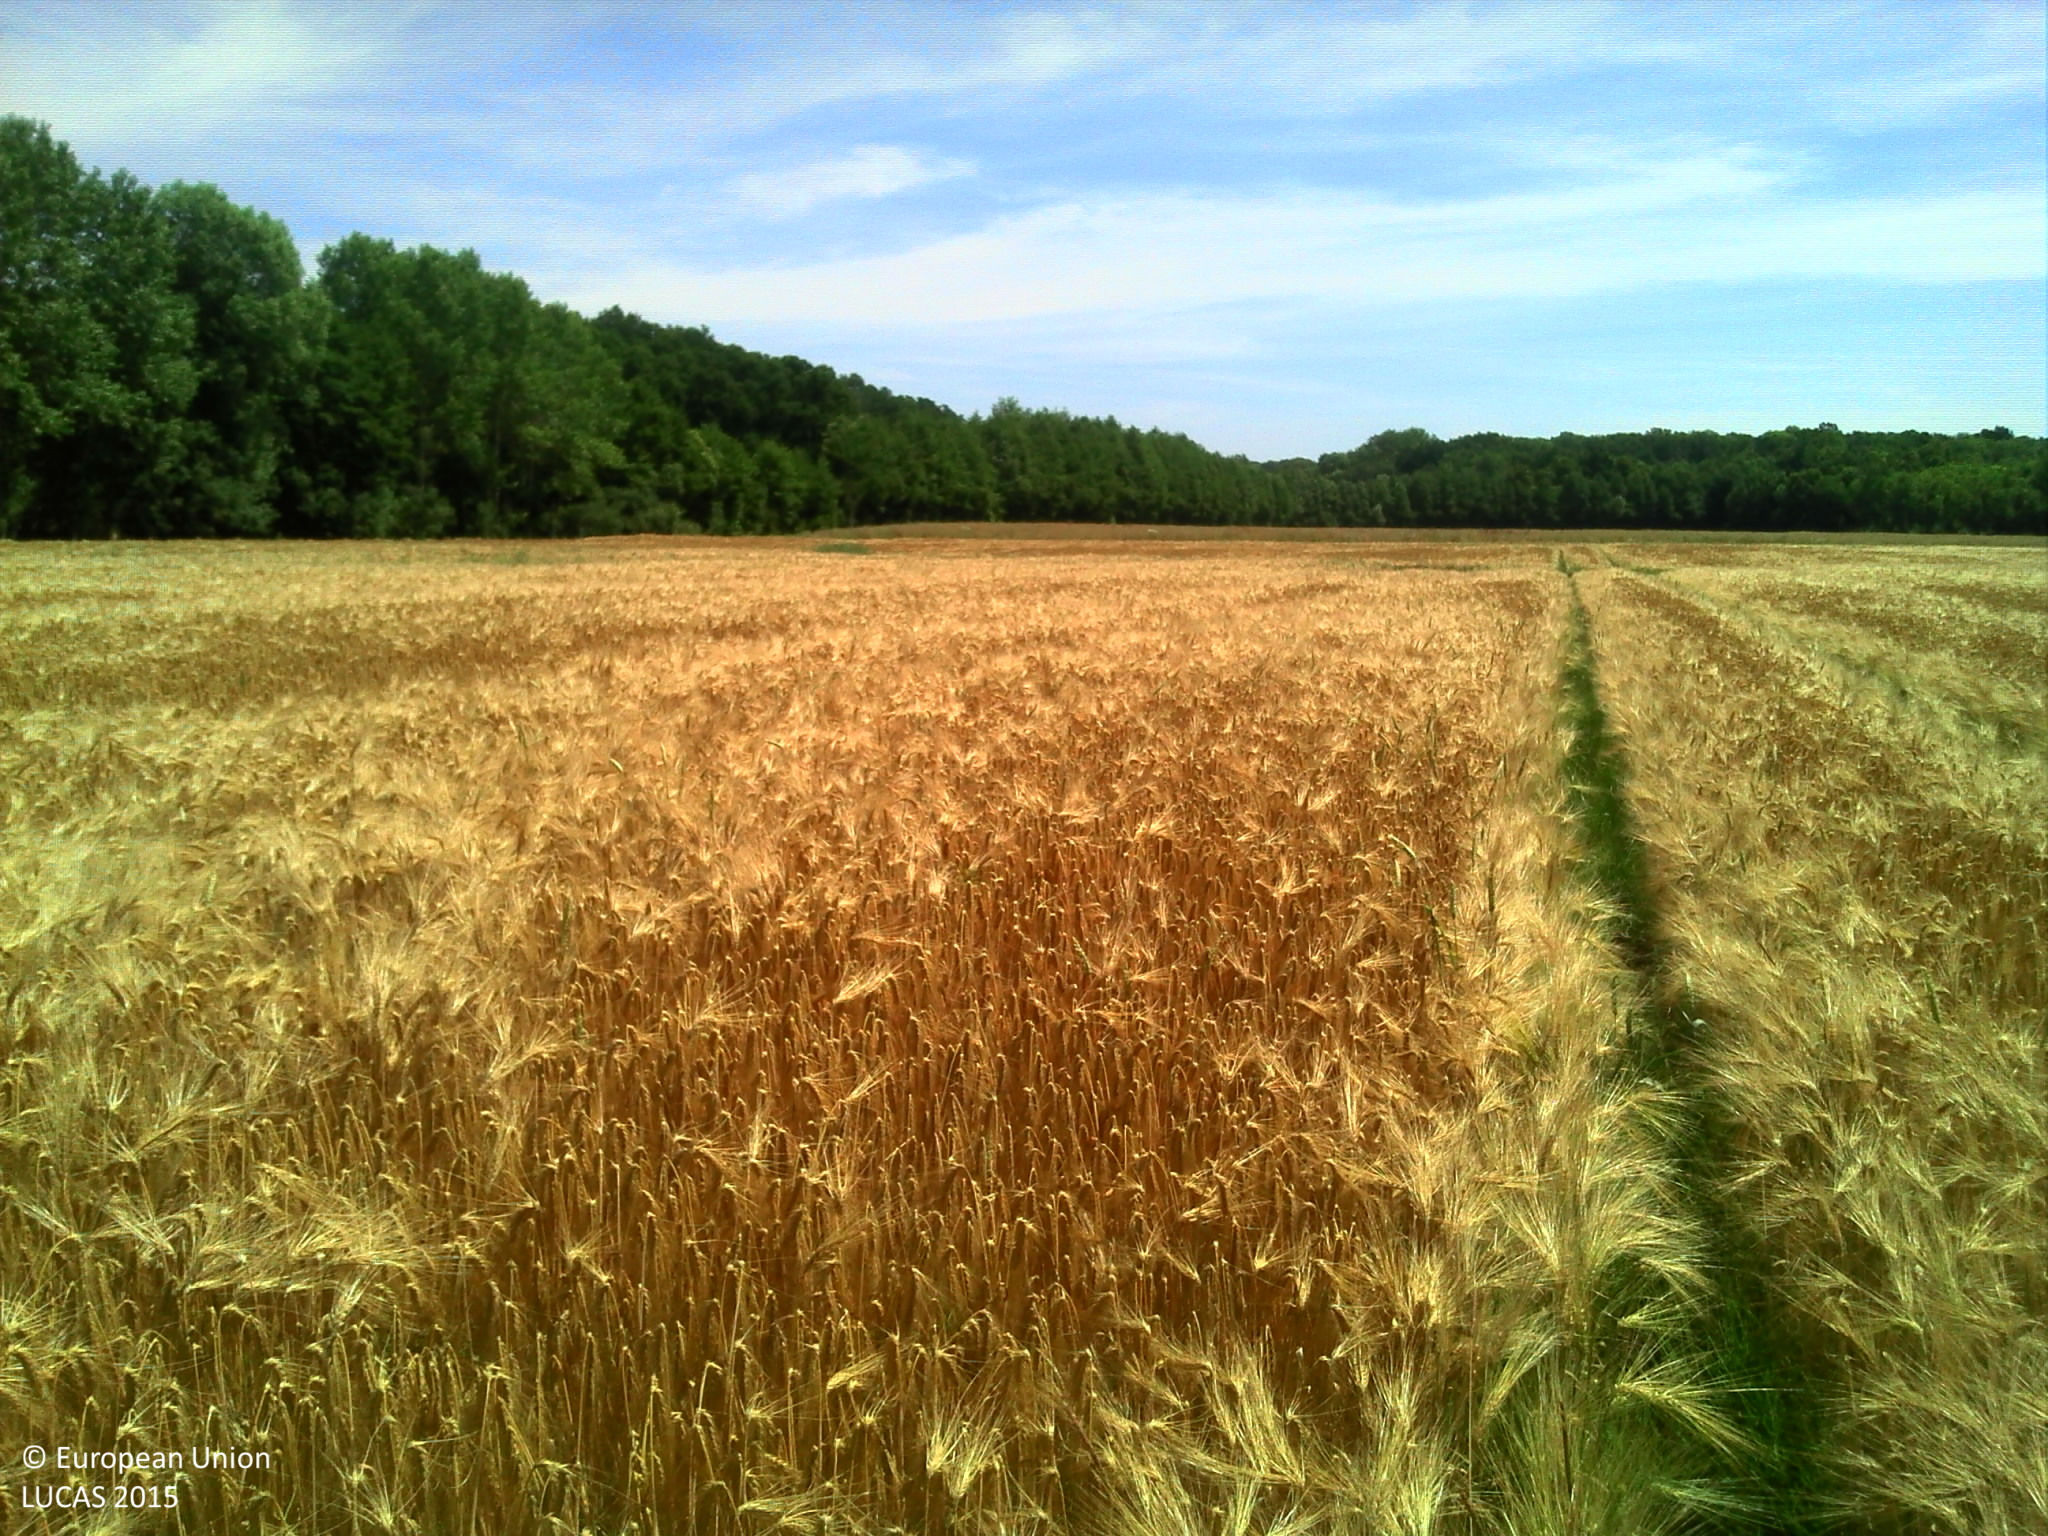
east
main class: Cropland
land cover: Barley
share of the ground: > 75 %
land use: Agriculture (excluding fallow land and kitchen gardens)
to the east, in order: Barley; Grassland without tree/shrub cover; Broadleaved woodland; Ditches and canals; Broadleaved woodland; Grassland without tree/shrub cover
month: June
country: FR
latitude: 48.7952
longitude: 5.0021
